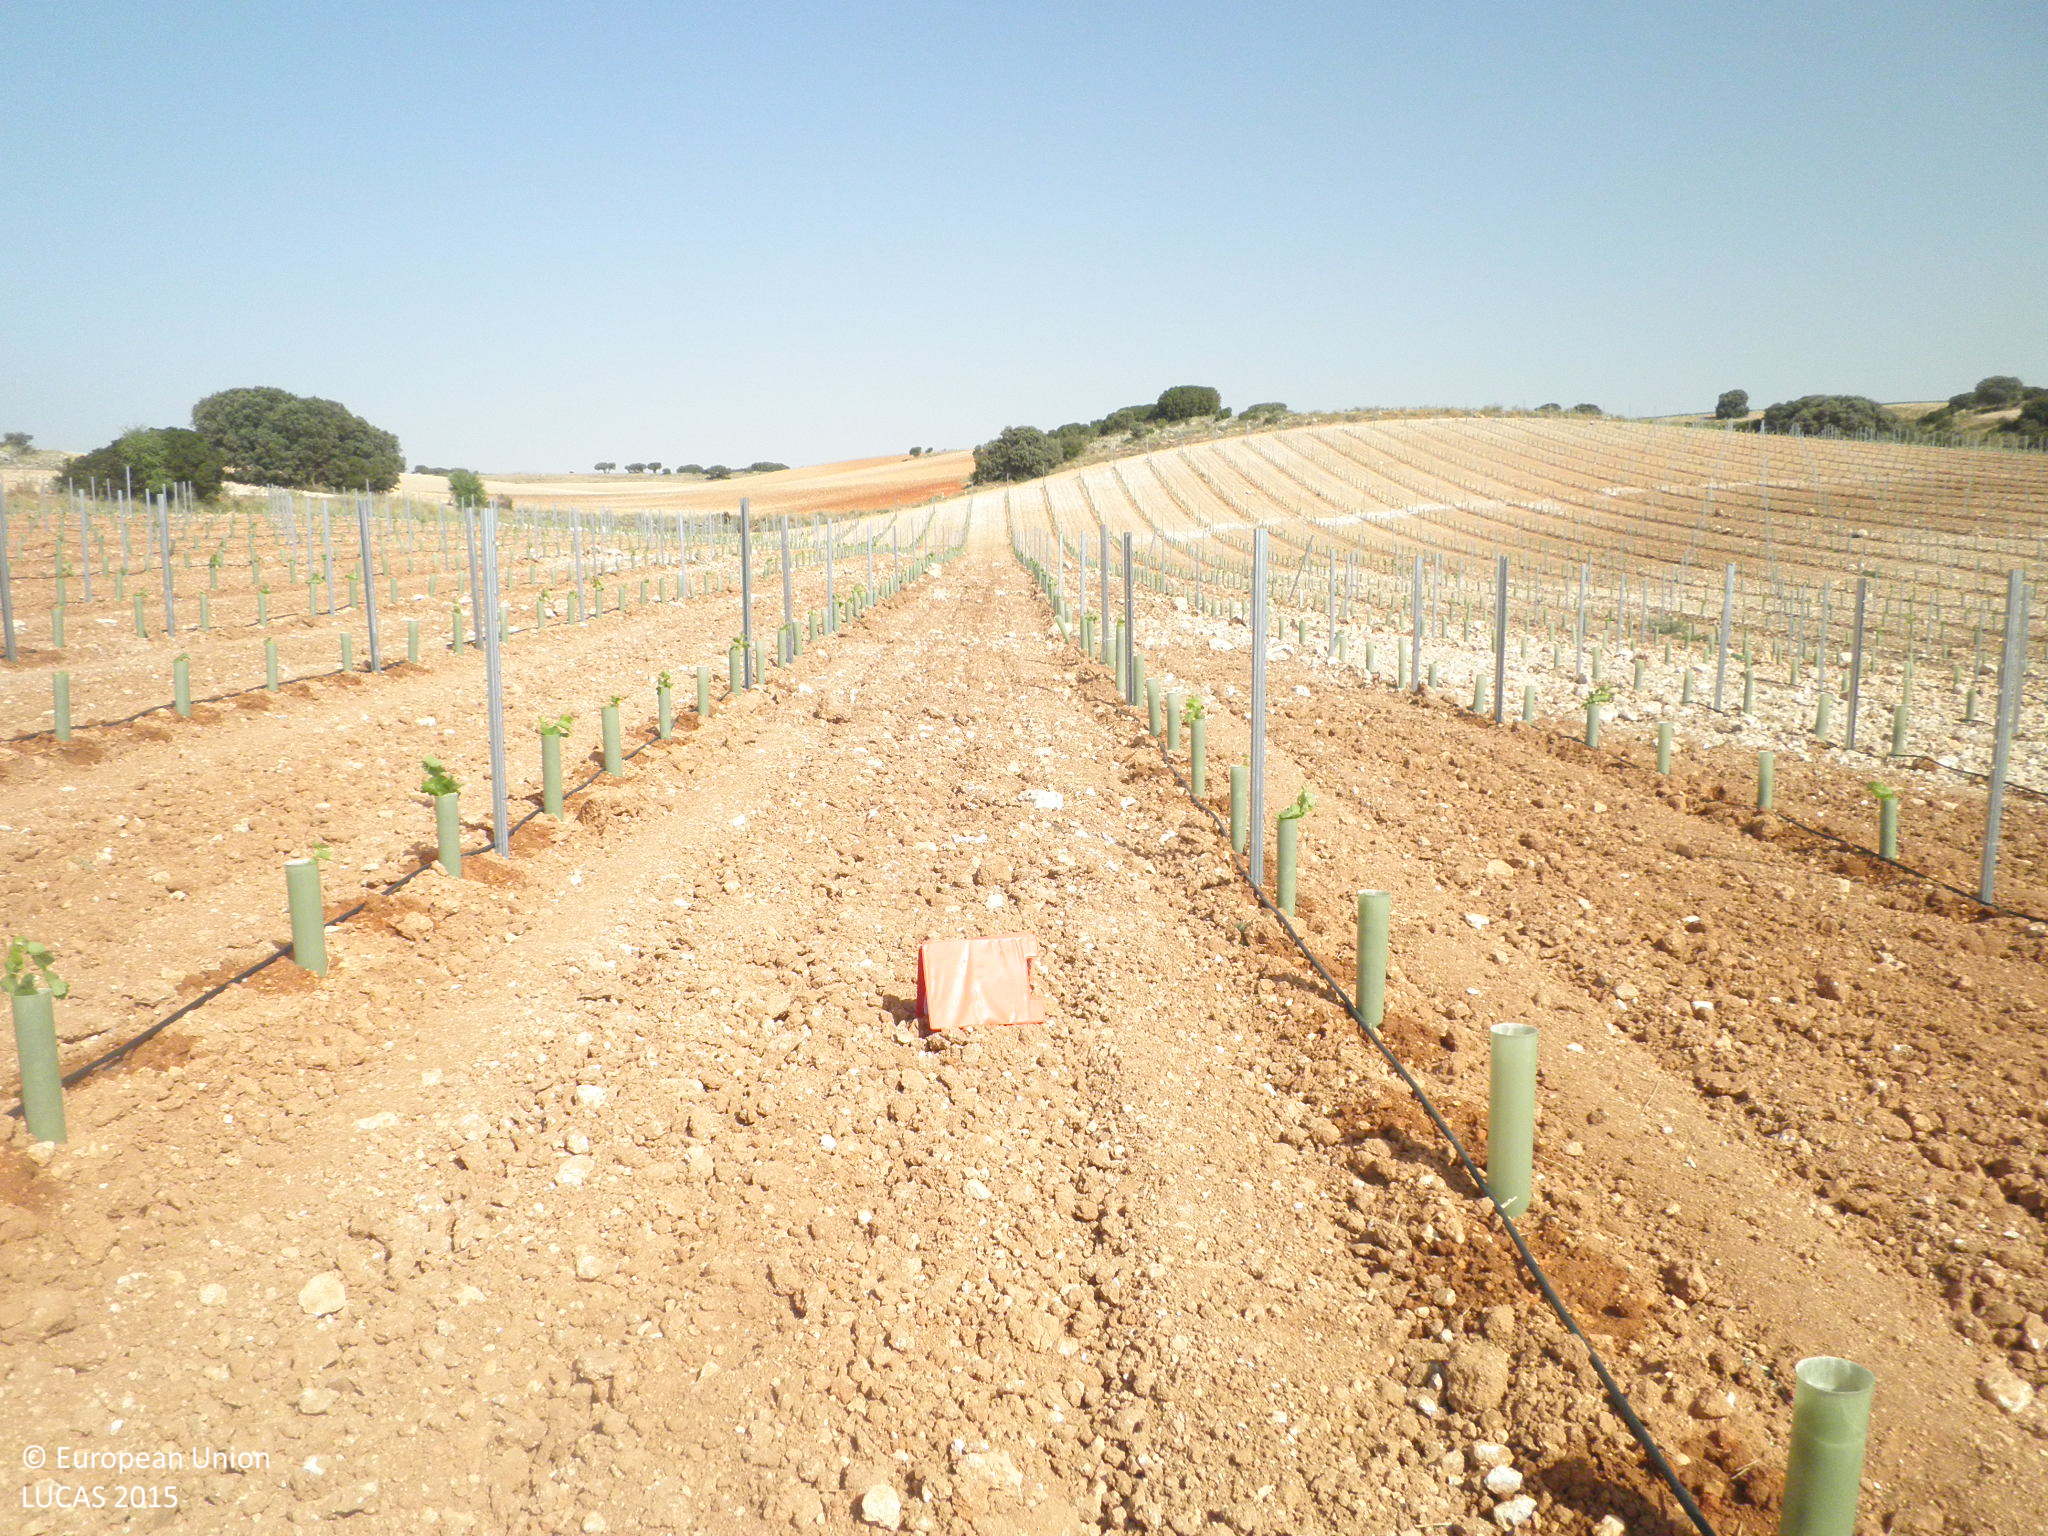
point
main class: Cropland
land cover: Vineyards
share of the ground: < 10 %
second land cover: Other bare soil
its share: > 75 %
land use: Agriculture (excluding fallow land and kitchen gardens)
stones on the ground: 10 - 25 %
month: July
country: ES
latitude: 39.6301
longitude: -2.6327
